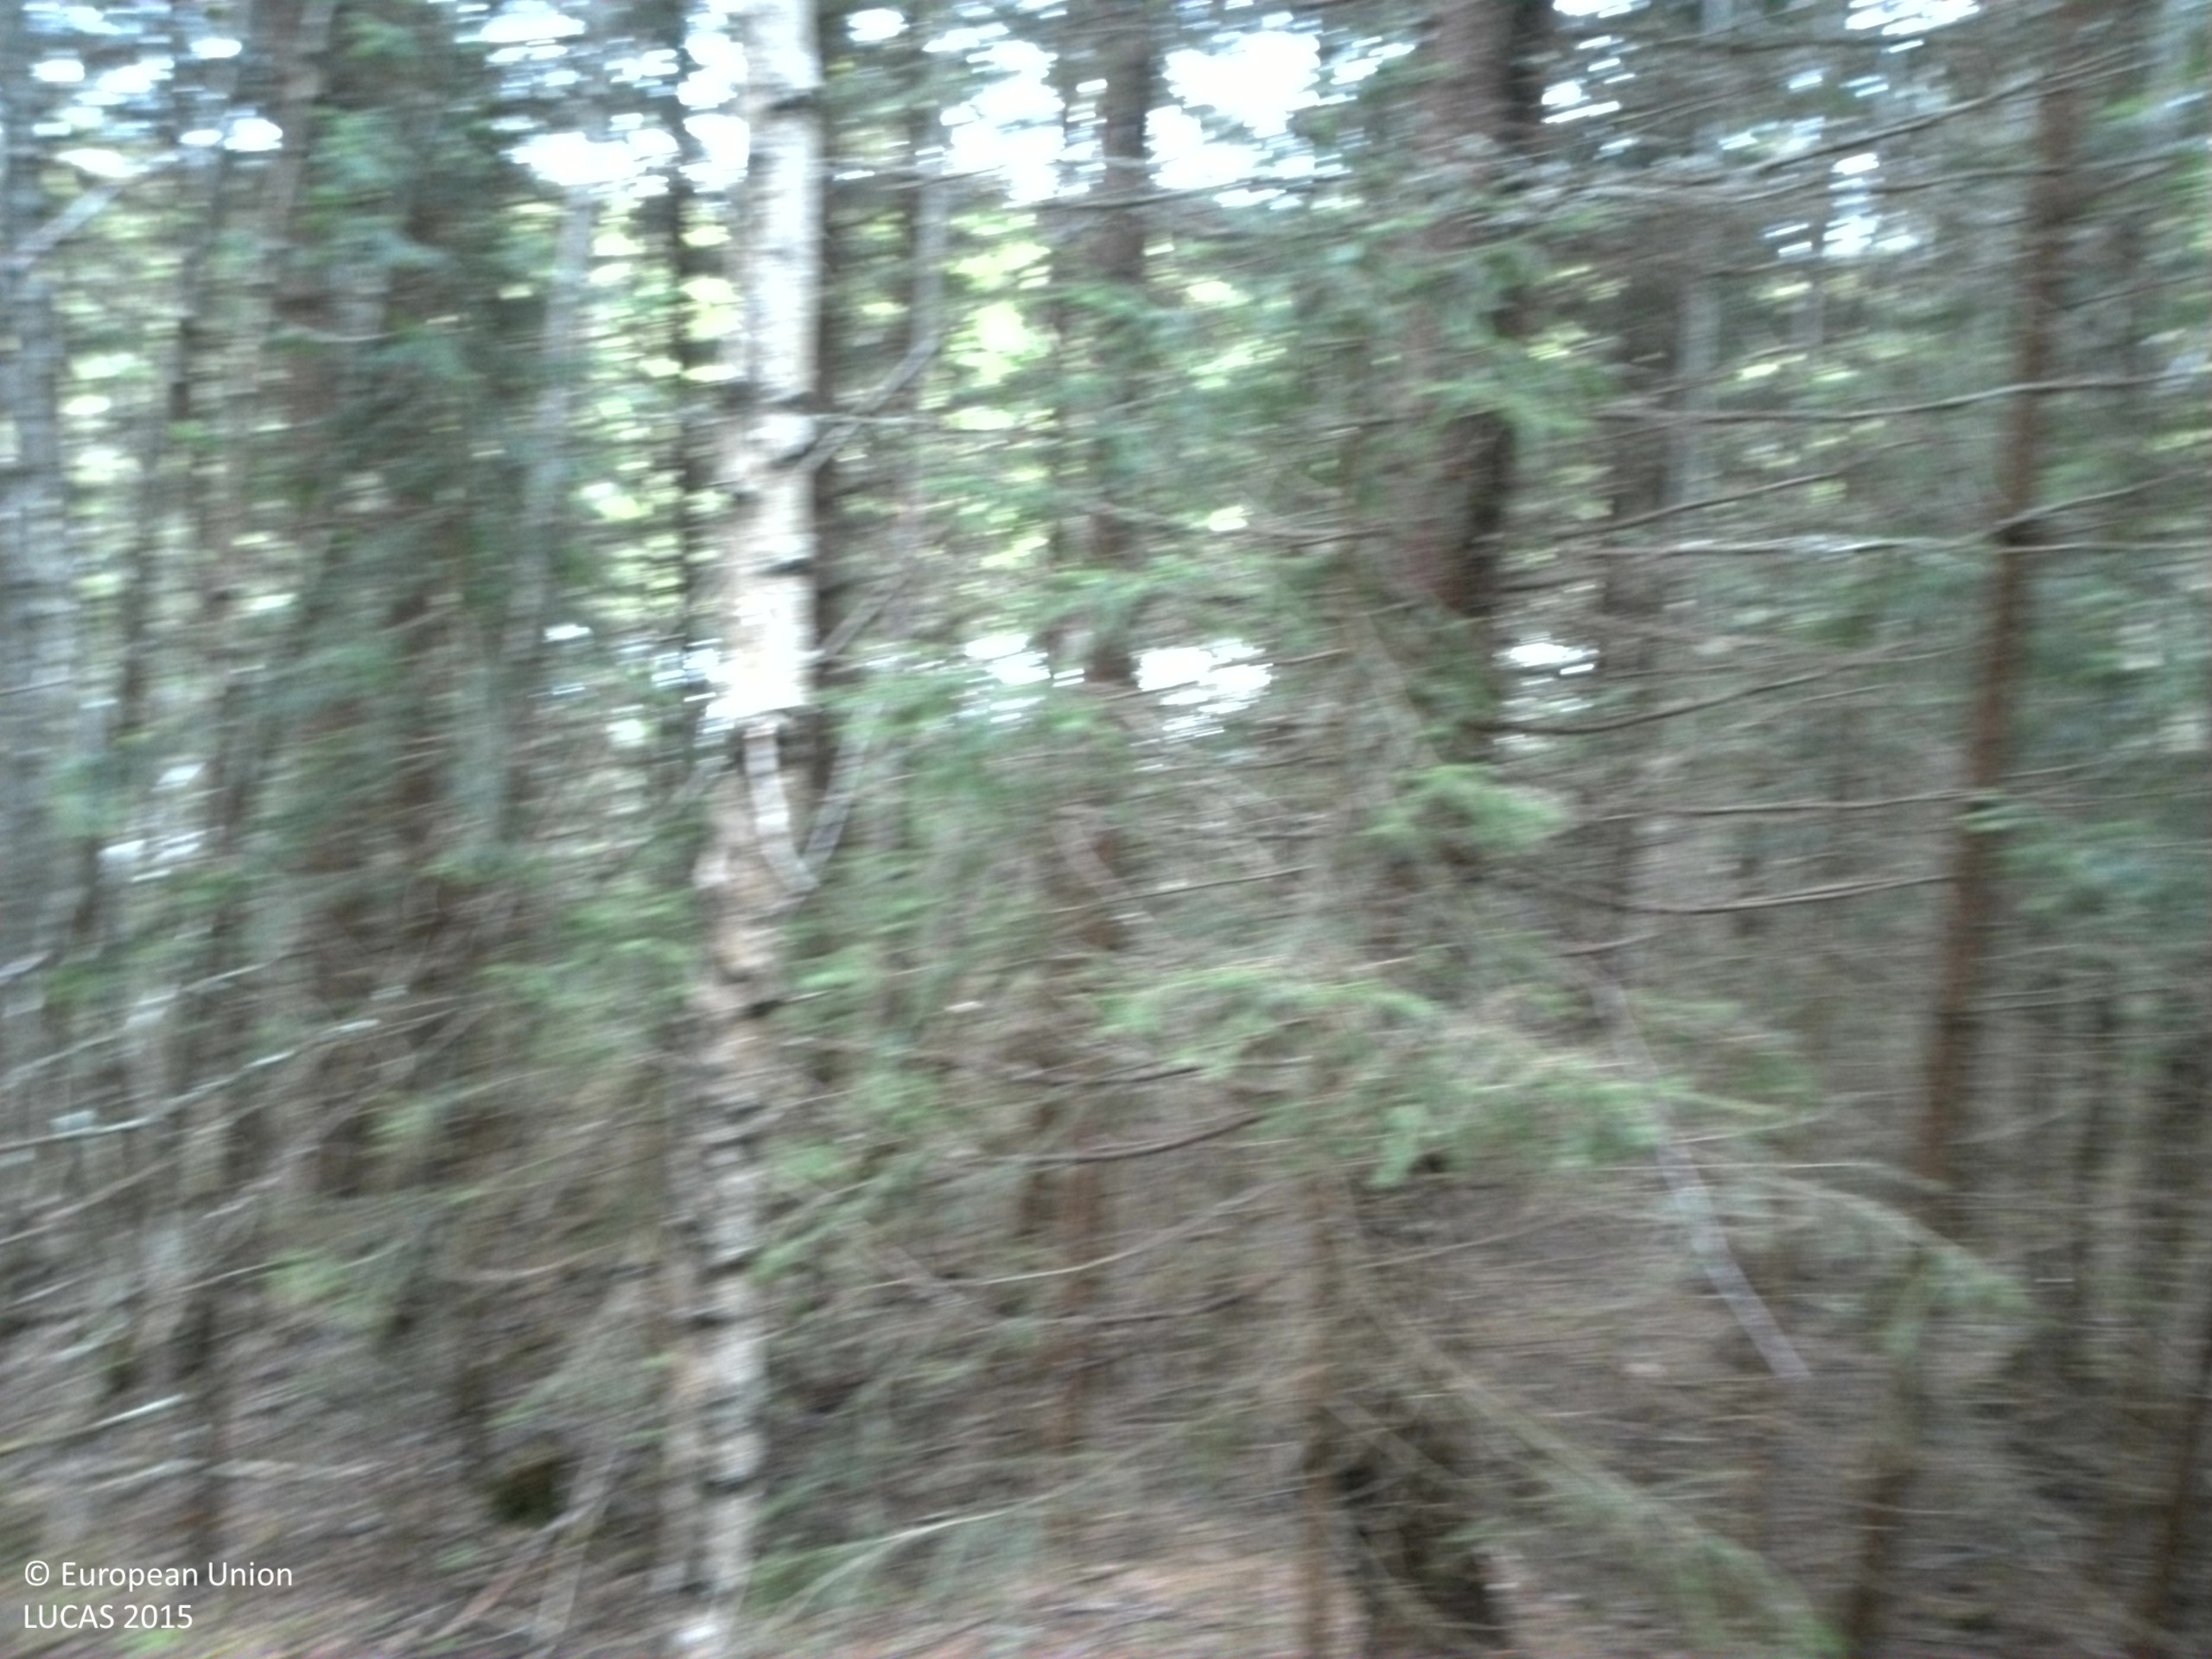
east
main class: Woodland
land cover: Spruce dominated mixed woodland
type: boreal forest
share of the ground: > 75 %
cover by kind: coniferous forest trees 65 %, broadleaved forest trees 25 %, herbaceous plants 10 %
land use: Forestry
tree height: > 5 m
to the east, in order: Spruce dominated mixed woodland; Other mixed woodland; Peatbogs; Inland fresh water bodies
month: May
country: SE
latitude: 62.8843
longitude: 17.7463
